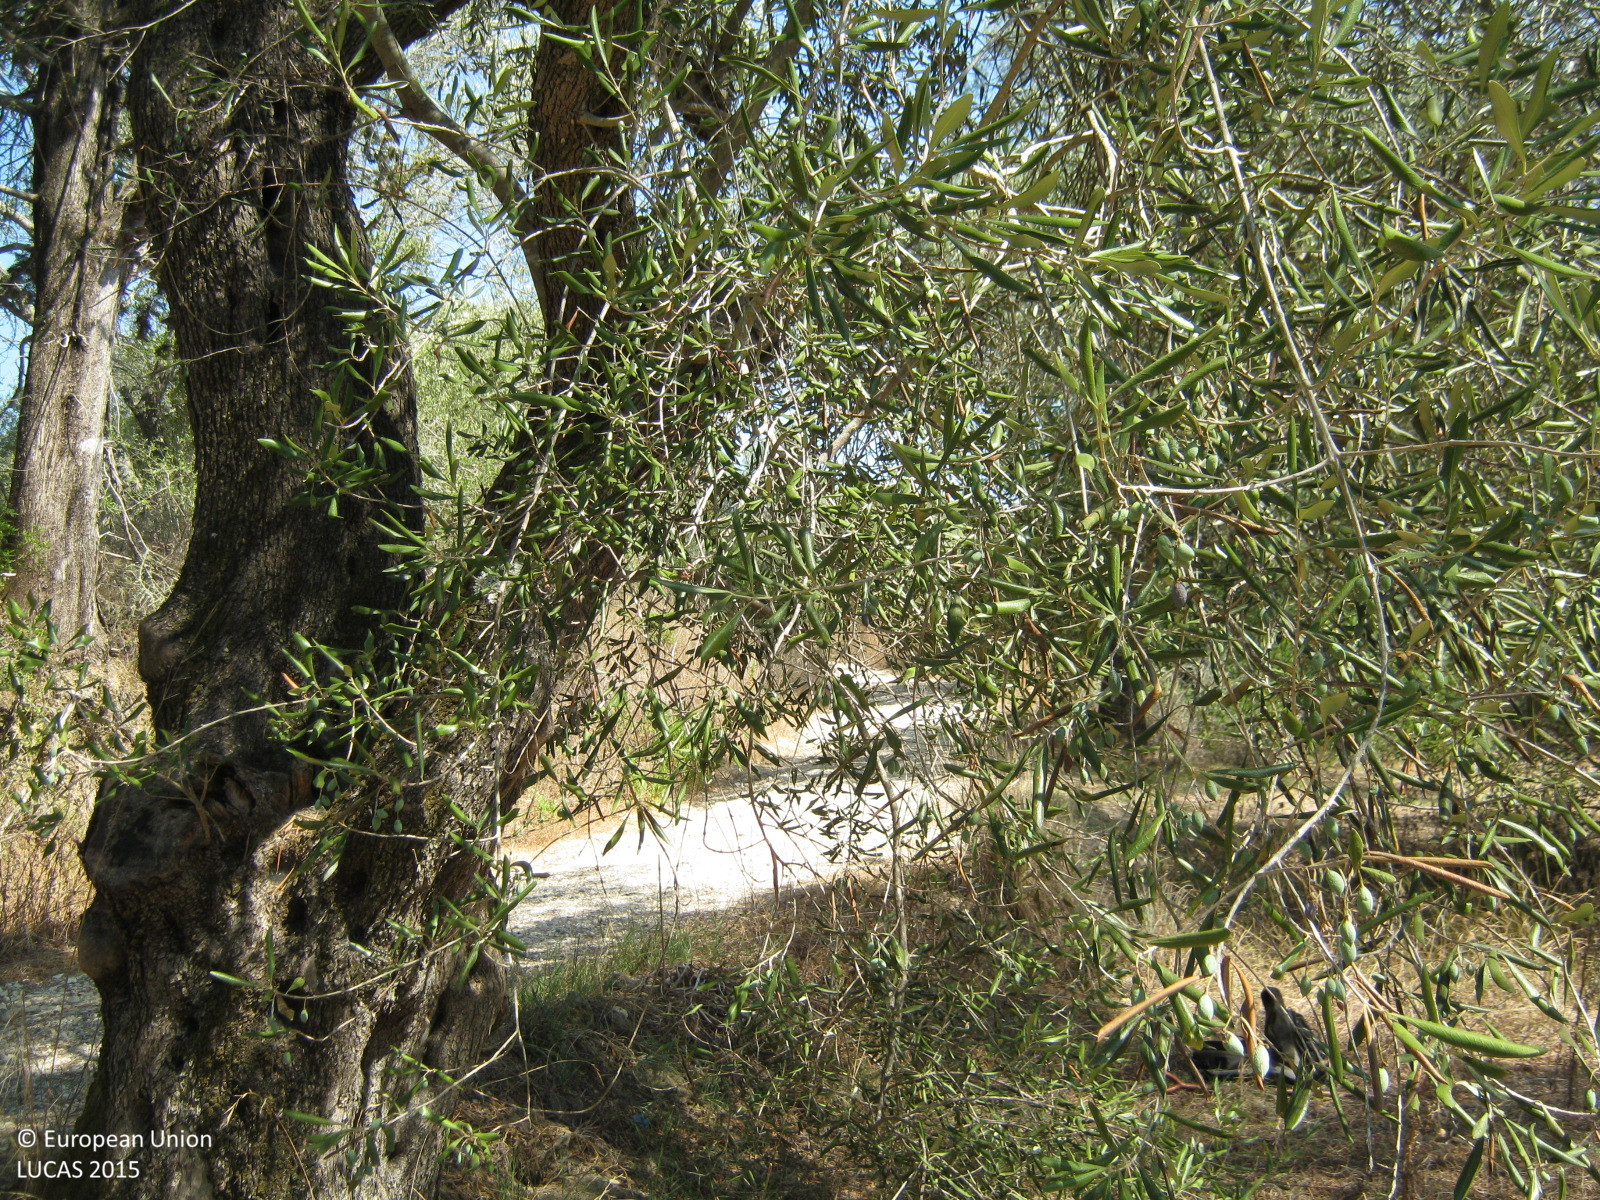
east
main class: Cropland
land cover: Olive groves
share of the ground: > 75 %
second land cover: Spontaneously vegetated surfaces
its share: > 75 %
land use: Agriculture (excluding fallow land and kitchen gardens)
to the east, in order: Olive groves; Spontaneously vegetated surfaces; Tracks; Olive groves; Tracks; Olive groves; Ditches and canals; Olive groves; Ditches and canals; Olive groves; Ditches and canals; Olive groves; Lines of trees; Olive groves
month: September
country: GR
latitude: 39.4297
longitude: 19.9744
